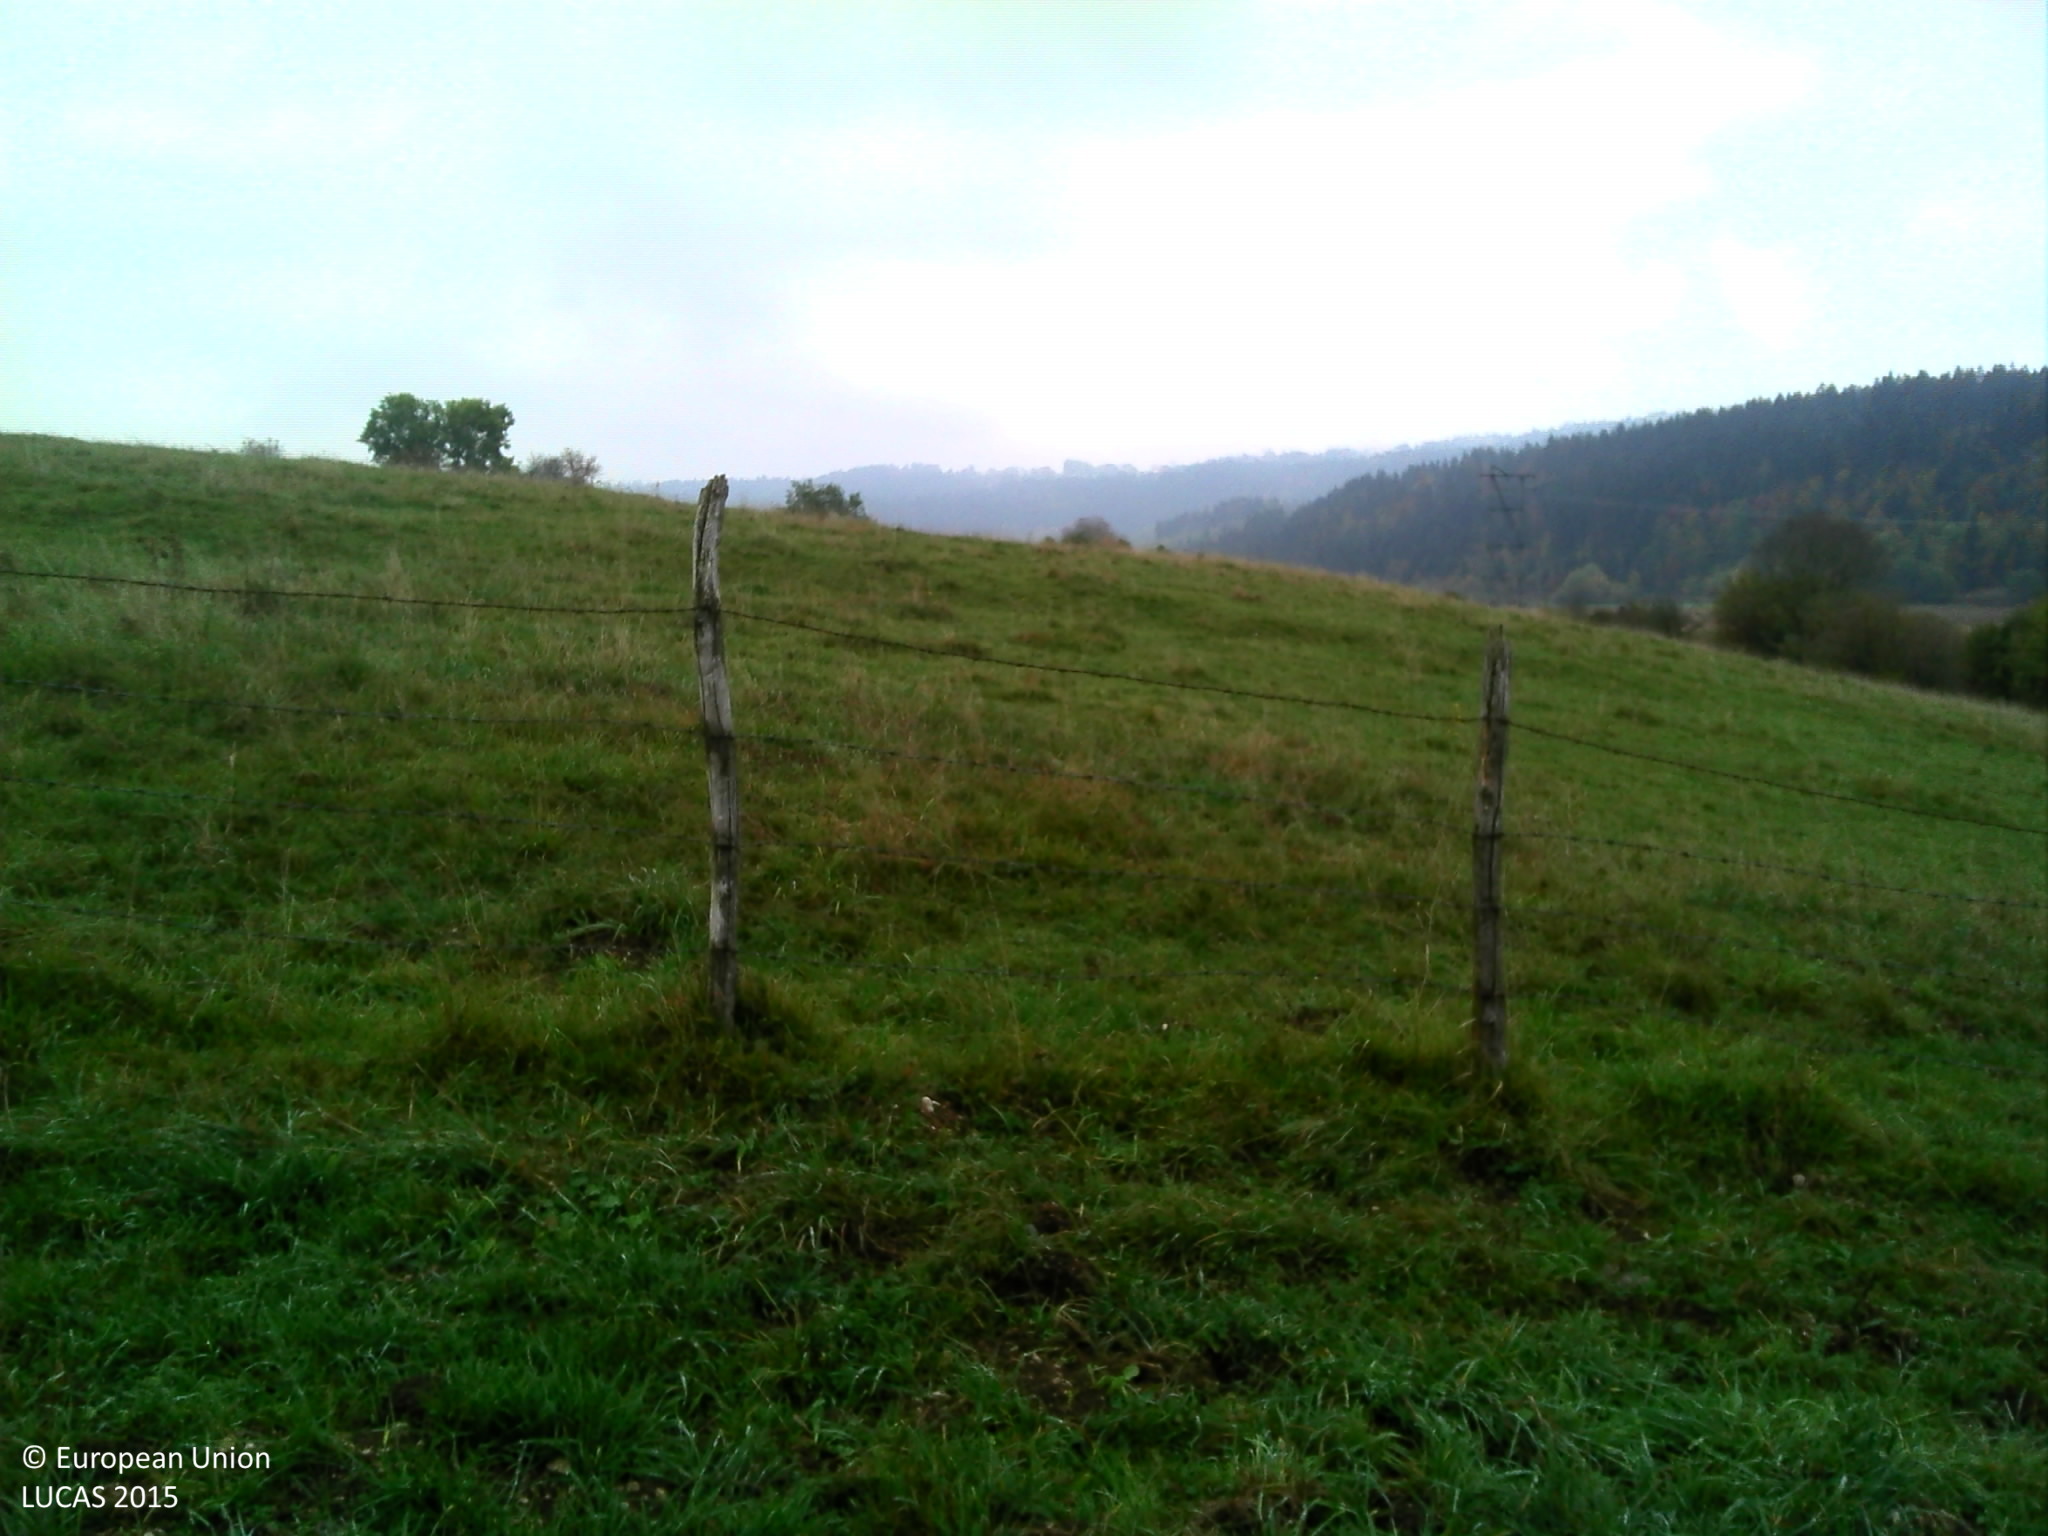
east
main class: Grassland
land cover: Grassland without tree/shrub cover
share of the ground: > 75 %
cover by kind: herbaceous plants 100 %
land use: Agriculture (excluding fallow land and kitchen gardens)
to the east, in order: Grassland without tree/shrub cover; Fences; Grassland without tree/shrub cover; Fences; Broadleaved woodland; Grassland without tree/shrub cover
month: October
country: FR
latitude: 46.8818
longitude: 6.2888
